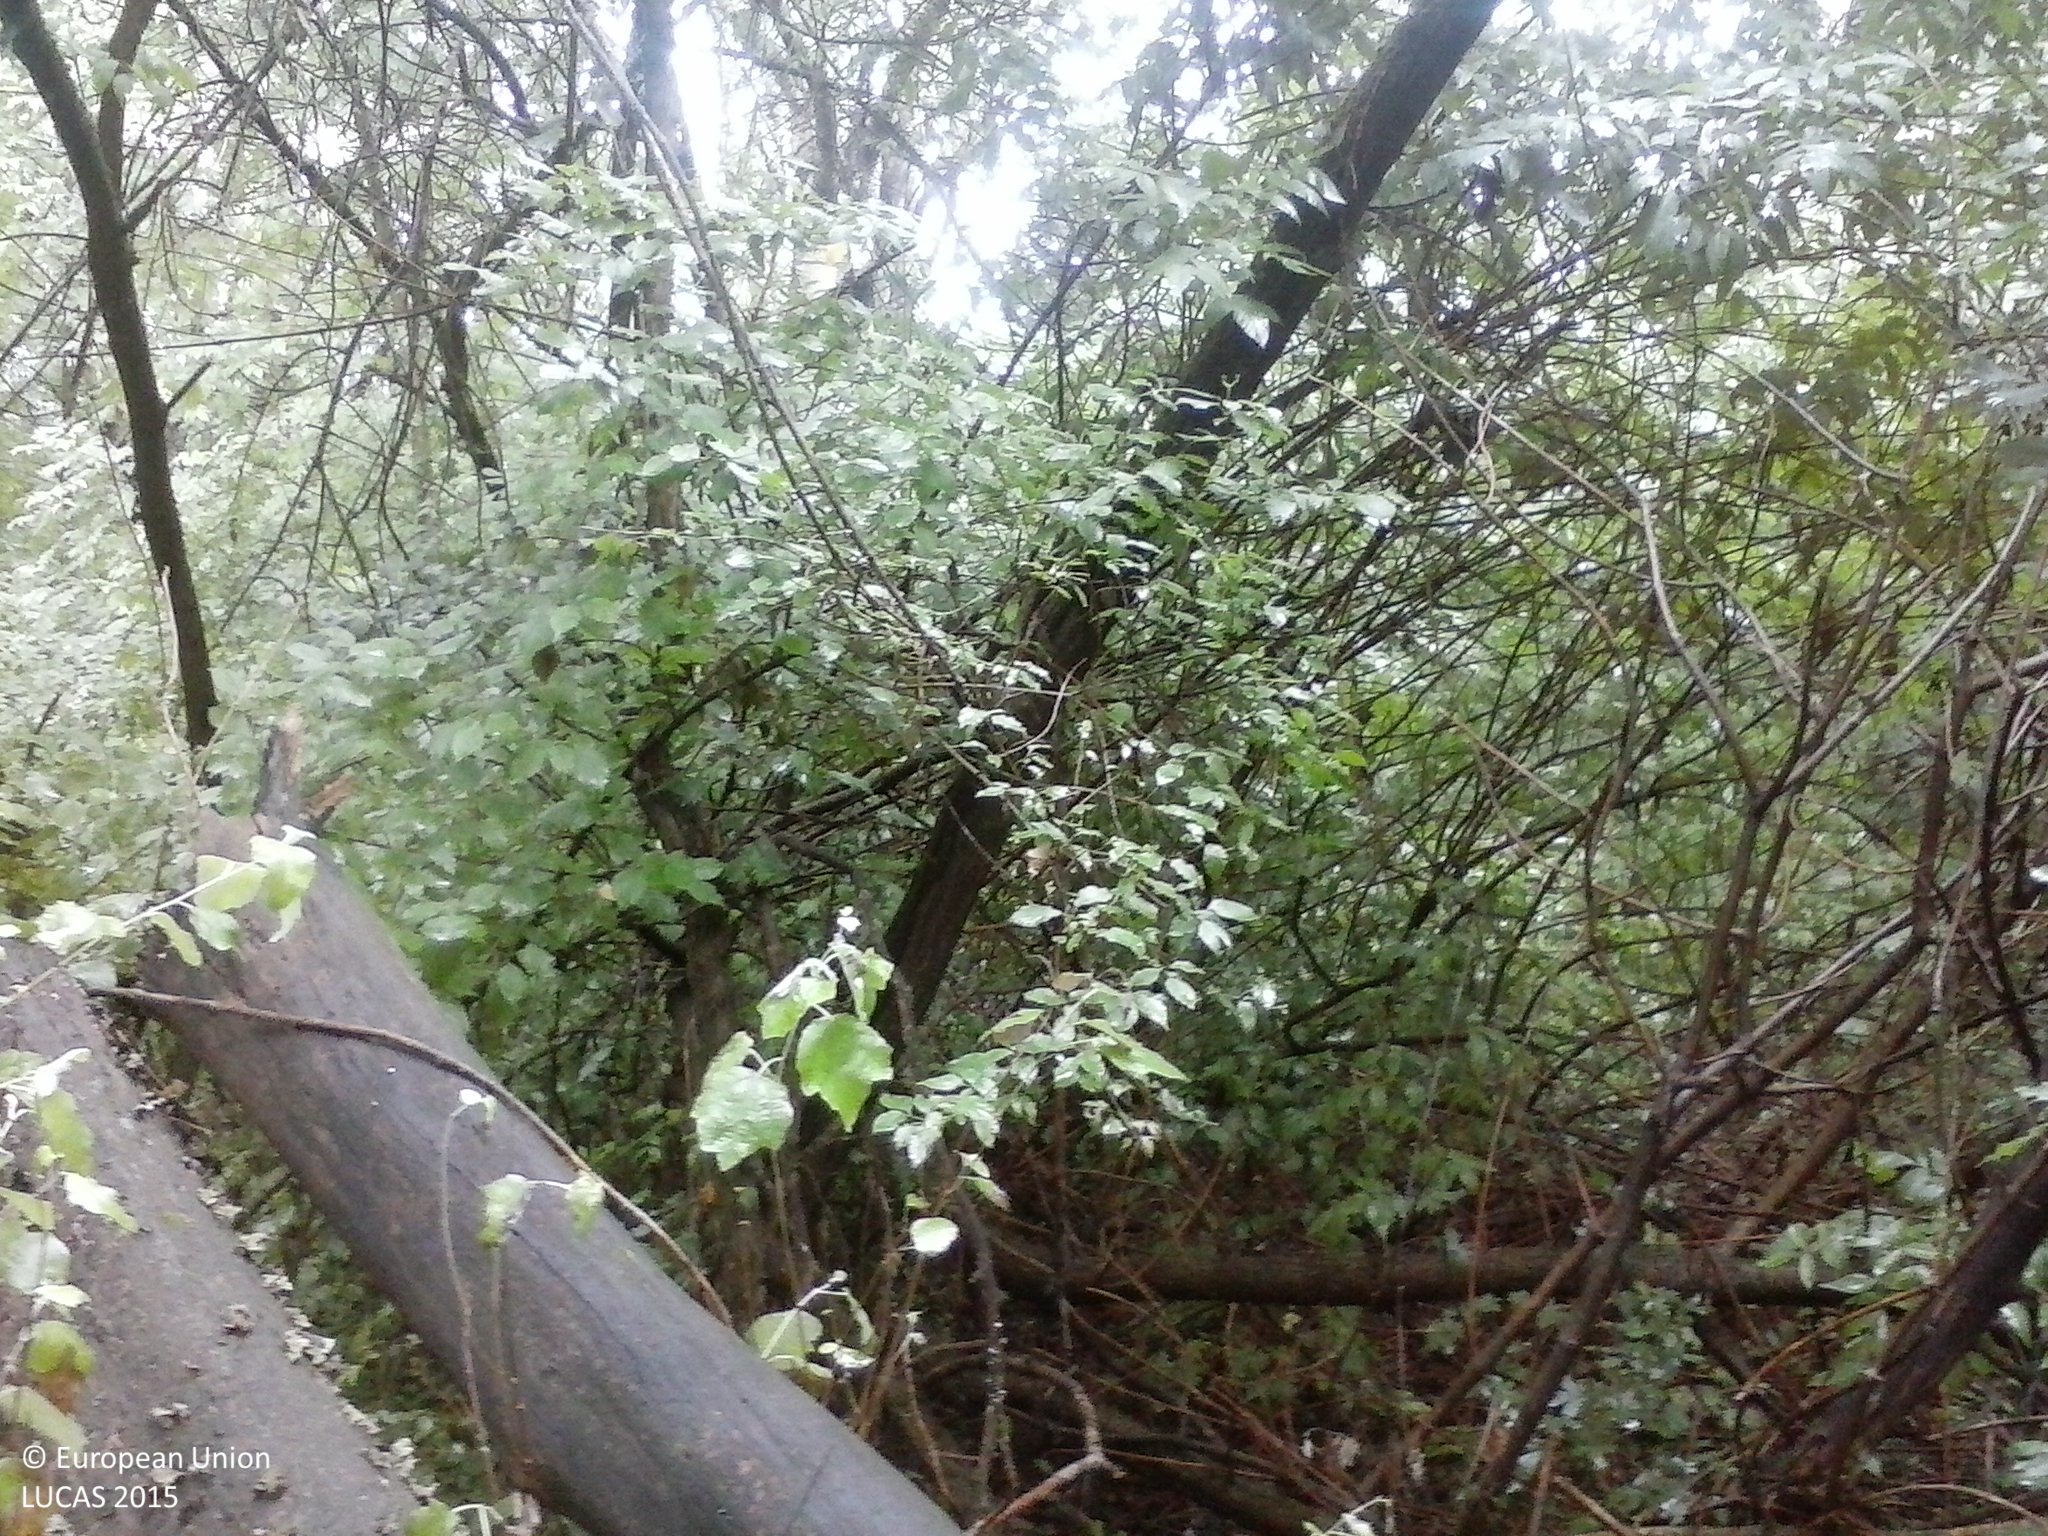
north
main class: Woodland
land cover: Broadleaved woodland
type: mesophytic deciduous forest
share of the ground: > 75 %
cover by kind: broadleaved forest trees 90 %, shrubs 5 %, herbaceous plants 5 %
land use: Semi-natural and natural areas not in use
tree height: > 5 m
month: July
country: HU
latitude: 45.9124
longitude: 17.6745
